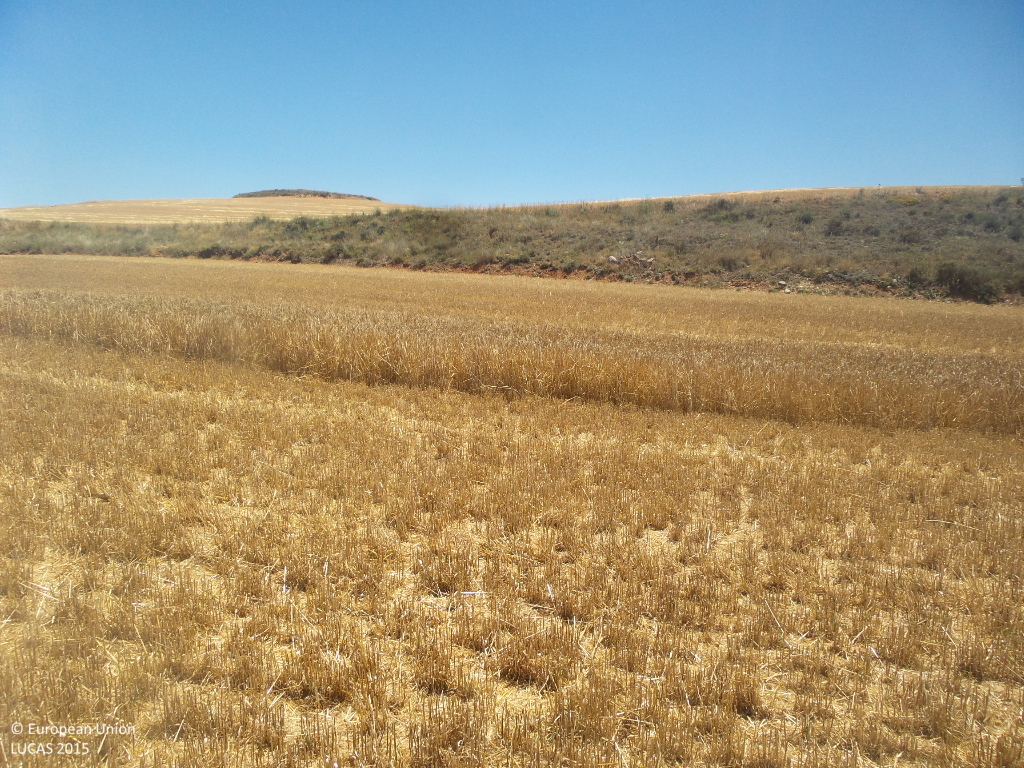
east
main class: Cropland
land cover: Barley
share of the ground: < 10 %
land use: Agriculture (excluding fallow land and kitchen gardens)
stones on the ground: < 10 %
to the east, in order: Barley; Shrubland without tree cover; Barley; Shrubland without tree cover; Tracks; Grass margins; Single bushes/trees; Barley
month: July
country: ES
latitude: 41.3968
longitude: -2.0983
